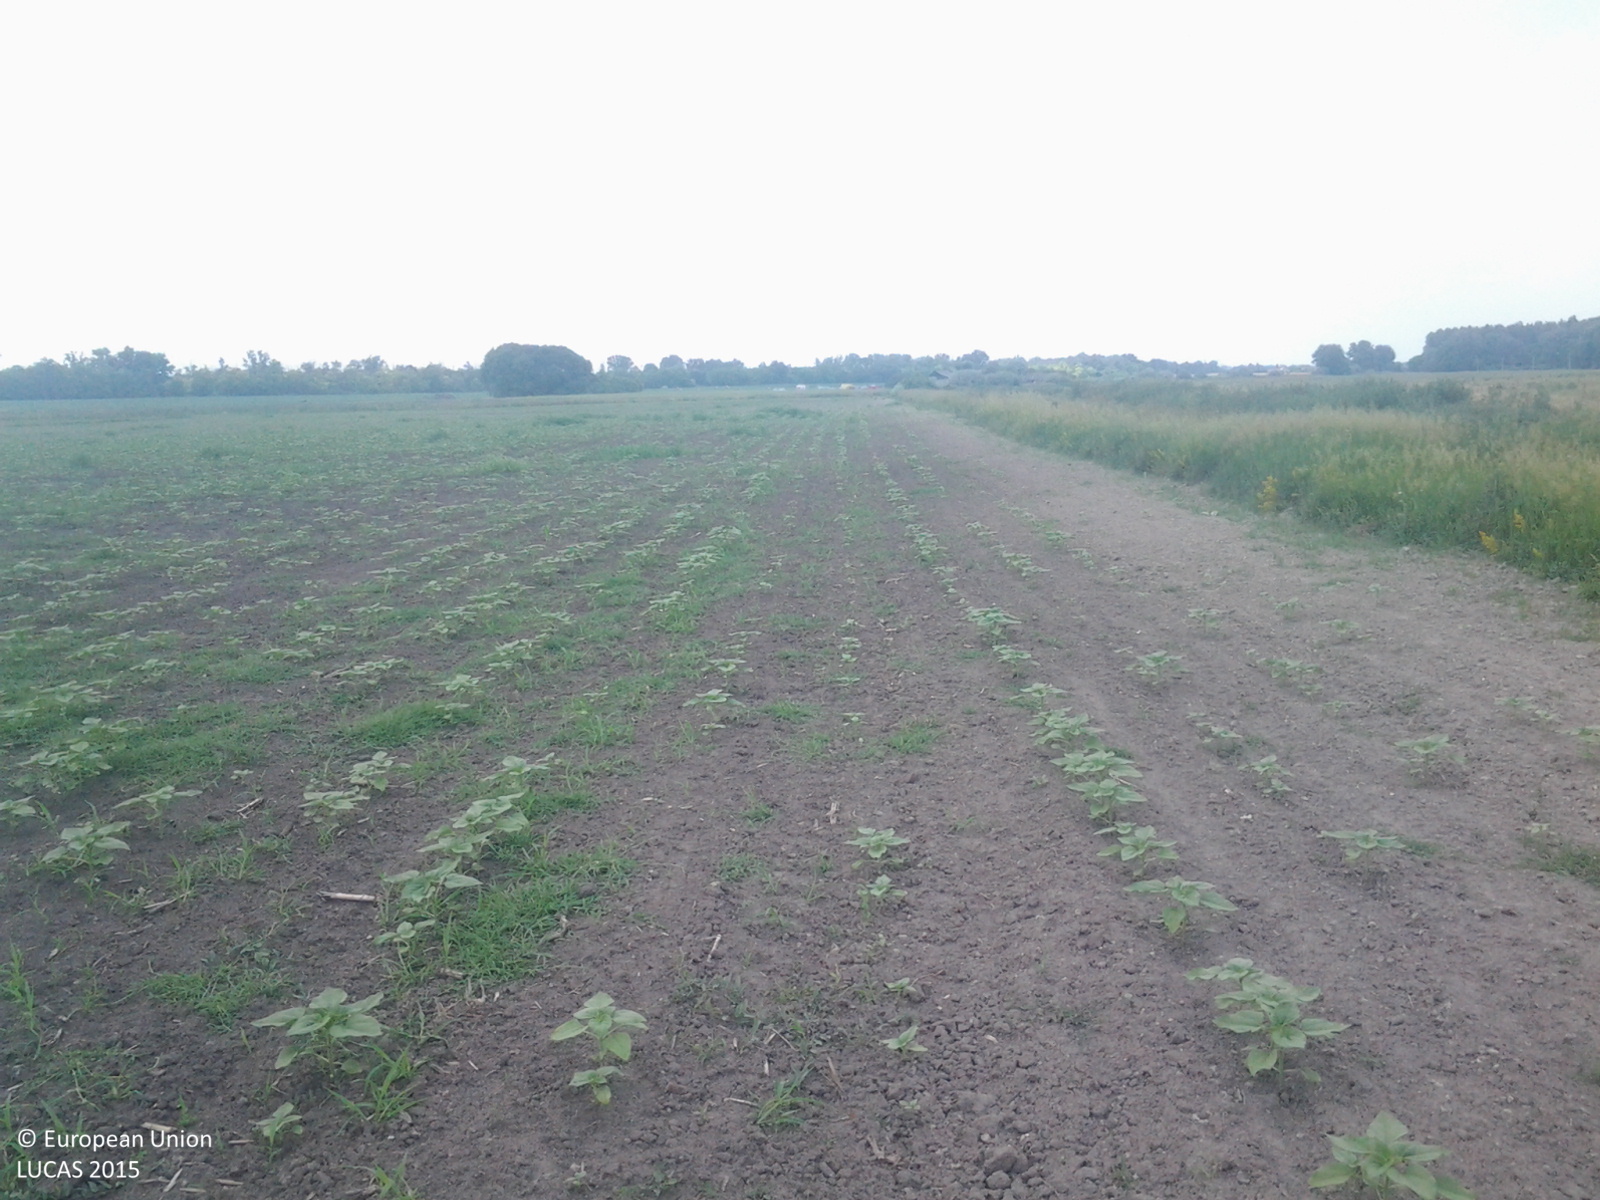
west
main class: Cropland
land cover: Sunflower
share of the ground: < 10 %
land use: Agriculture (excluding fallow land and kitchen gardens)
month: June
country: HU
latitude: 46.8821
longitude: 19.7712
